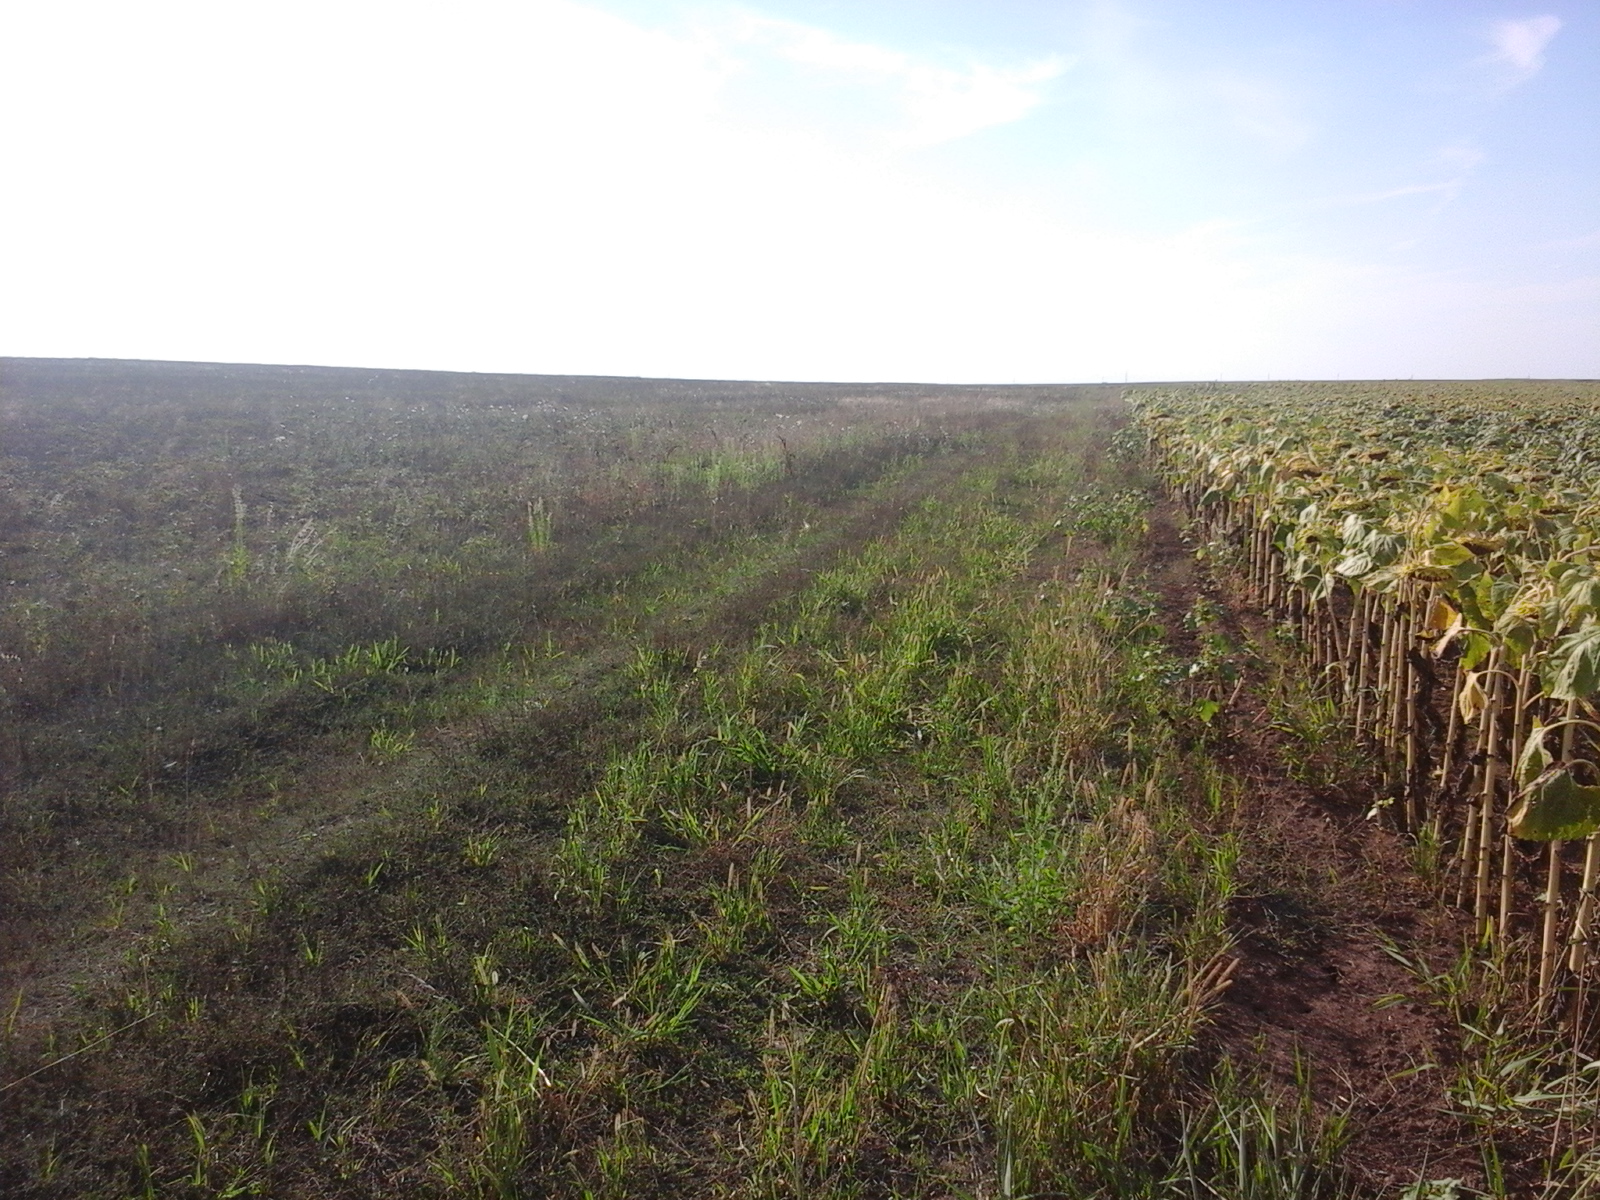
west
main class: Cropland
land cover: Sunflower
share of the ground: > 75 %
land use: Agriculture (excluding fallow land and kitchen gardens)
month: August
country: RO
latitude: 46.0370
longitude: 21.3393
